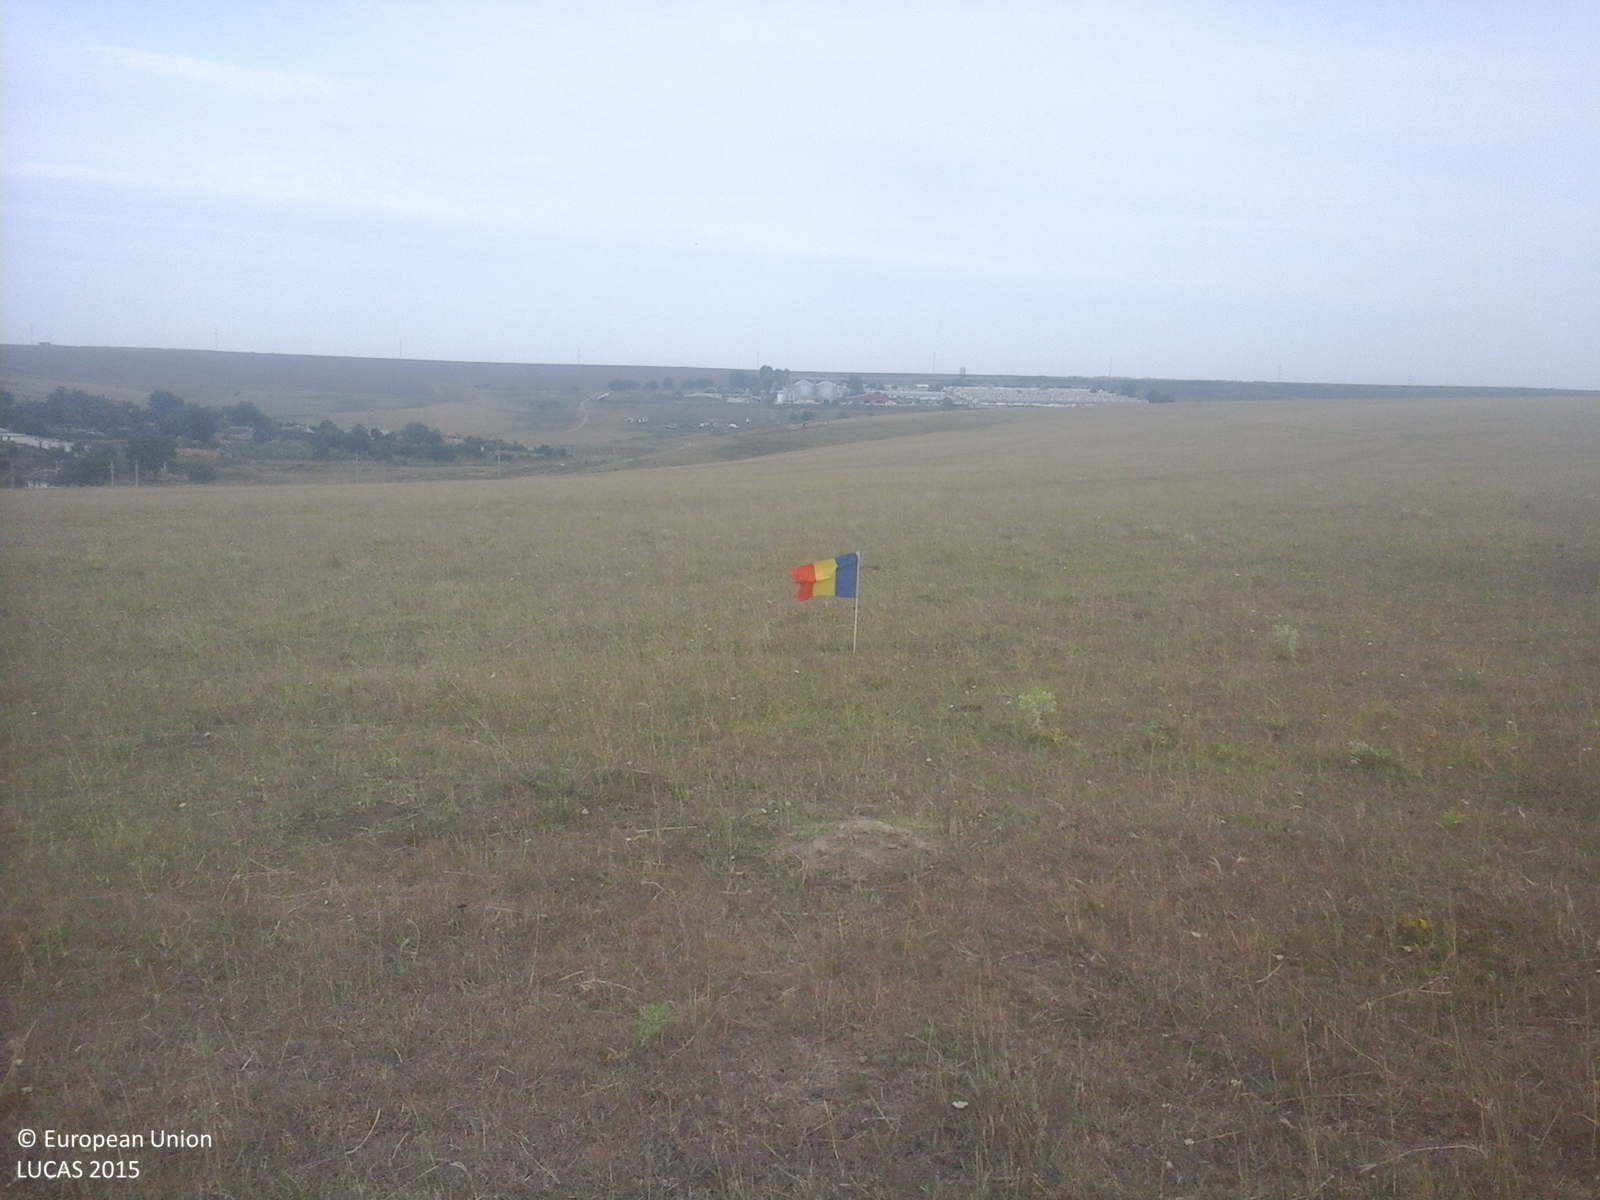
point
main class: Grassland
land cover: Grassland without tree/shrub cover
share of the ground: > 75 %
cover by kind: herbaceous plants 100 %
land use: Agriculture (excluding fallow land and kitchen gardens)
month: August
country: RO
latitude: 43.9710
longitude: 28.1426
